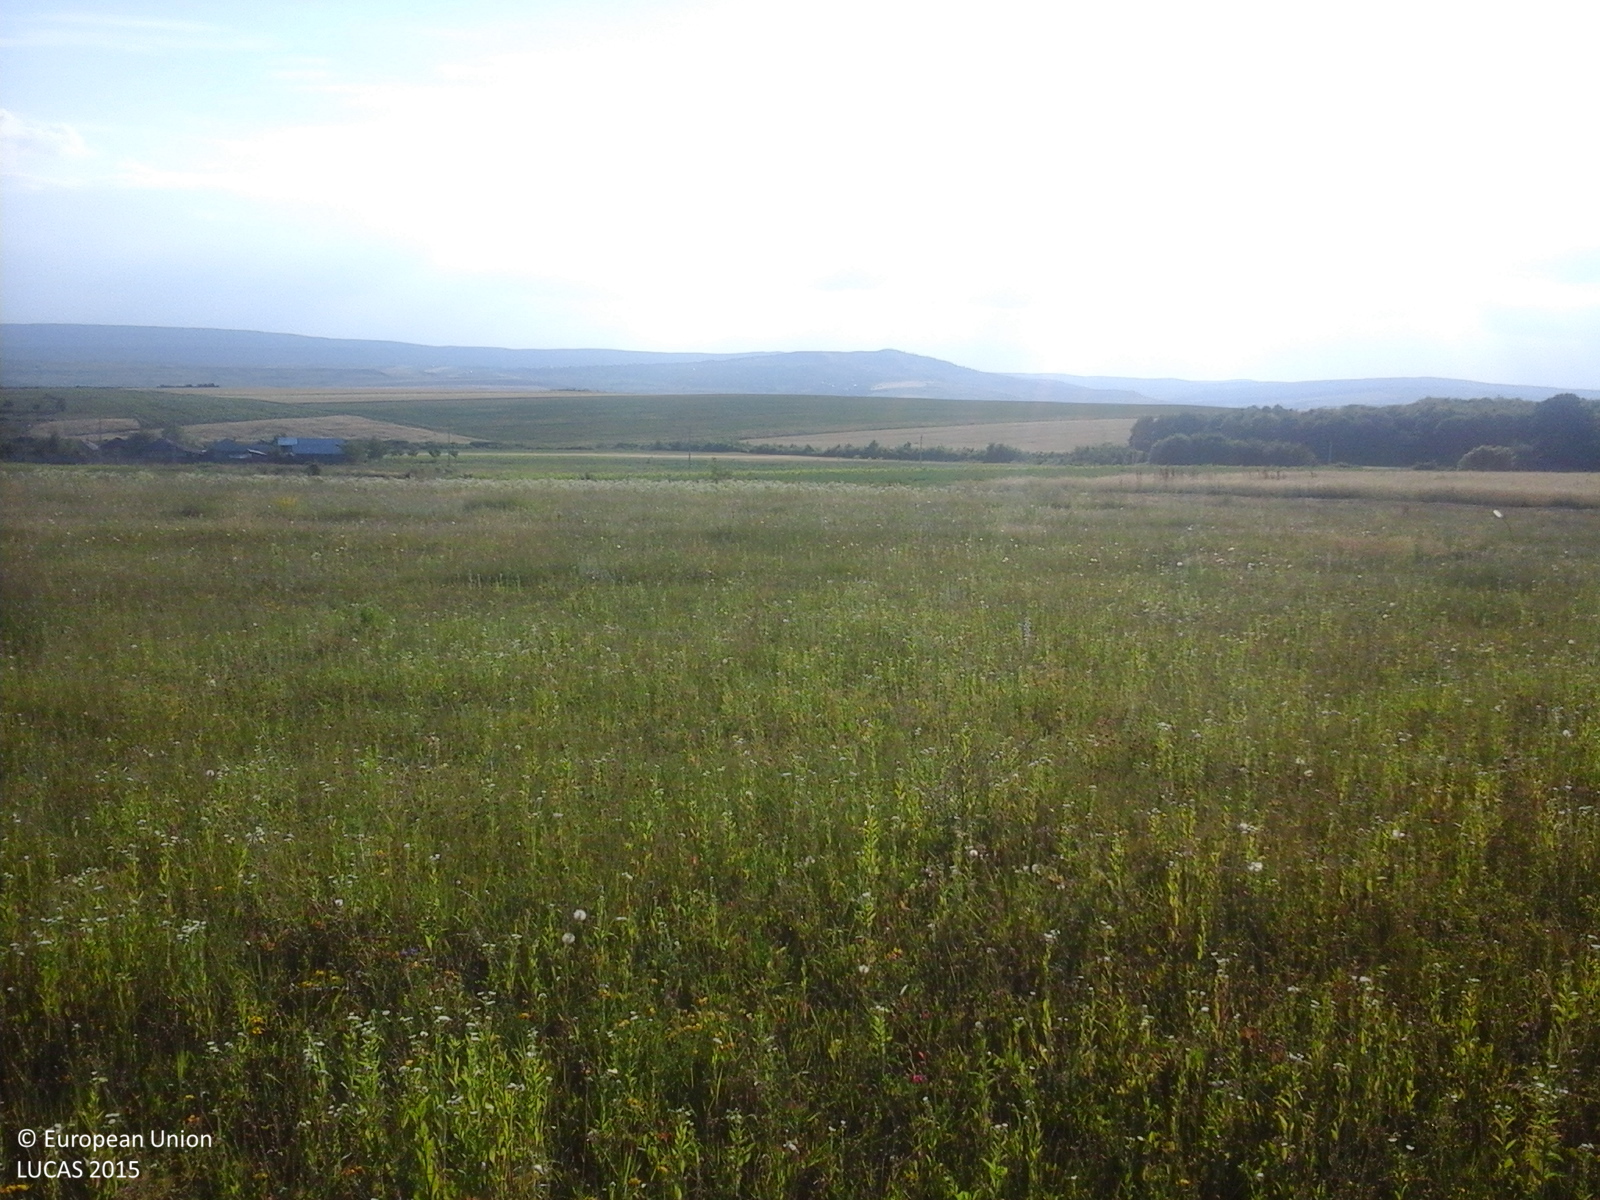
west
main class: Grassland
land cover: Grassland without tree/shrub cover
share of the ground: > 75 %
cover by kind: herbaceous plants 100 %
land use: Agriculture (excluding fallow land and kitchen gardens)
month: June
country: RO
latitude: 46.9774
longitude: 27.3706
